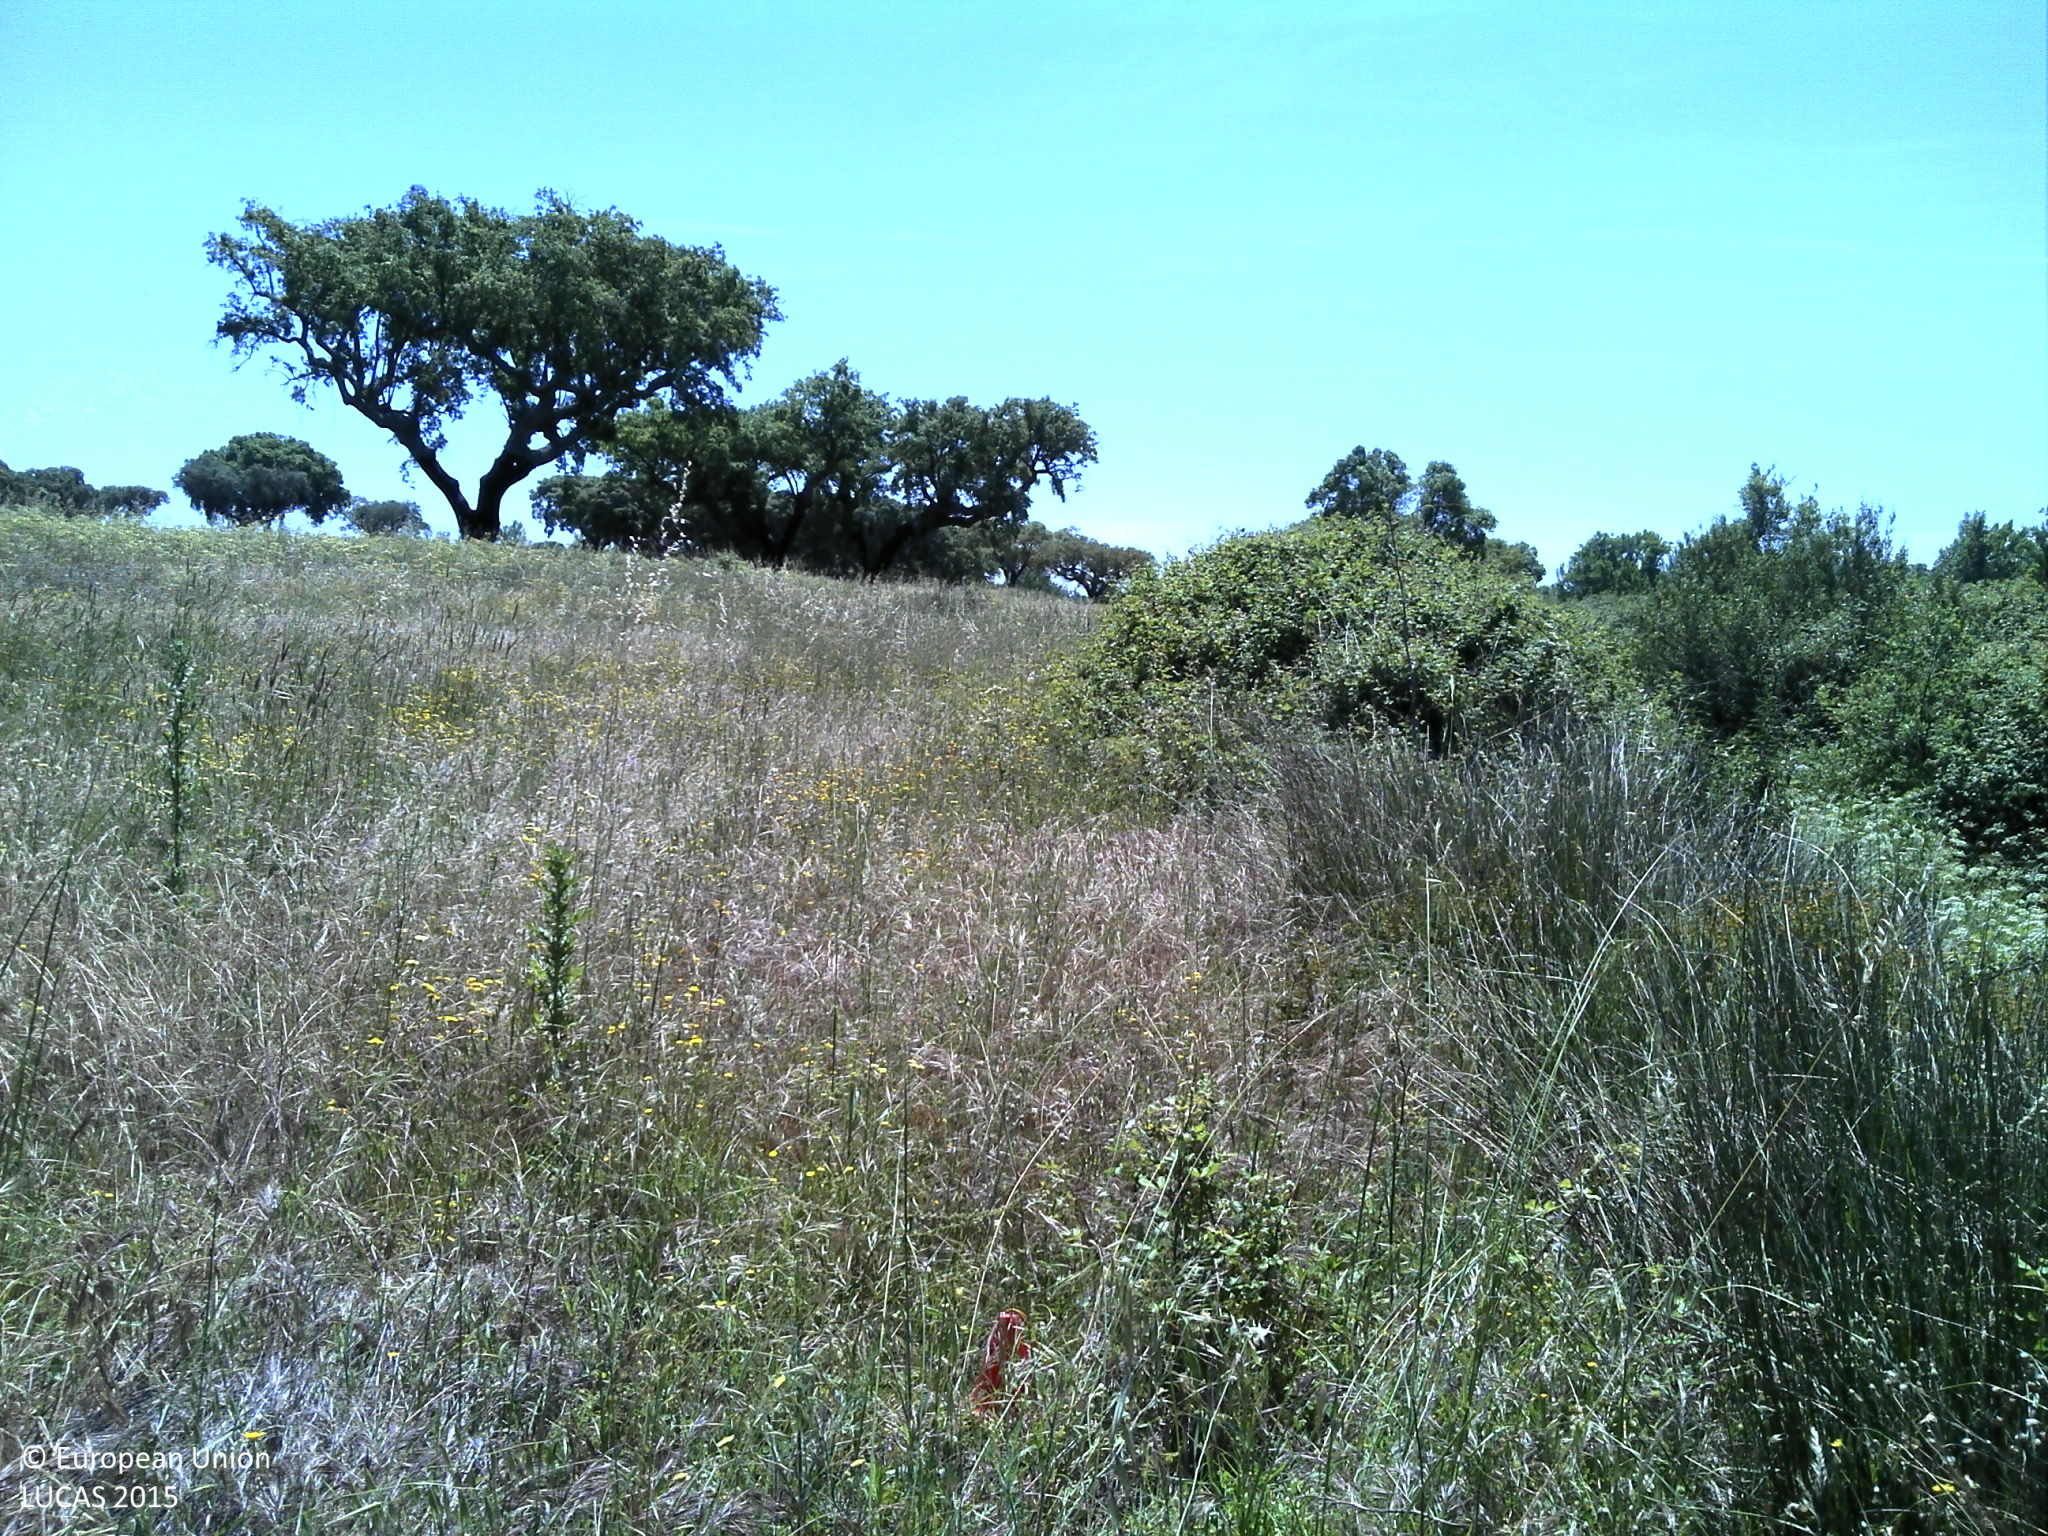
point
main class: Grassland
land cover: Grassland with sparse tree/shrub cover
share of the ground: > 75 %
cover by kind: herbaceous plants 90 %, broadleaved forest trees 5 %, unconsolidated bare surface 5 %
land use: Agriculture (excluding fallow land and kitchen gardens)
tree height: > 5 m
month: May
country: PT
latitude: 39.2026
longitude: -7.8718
